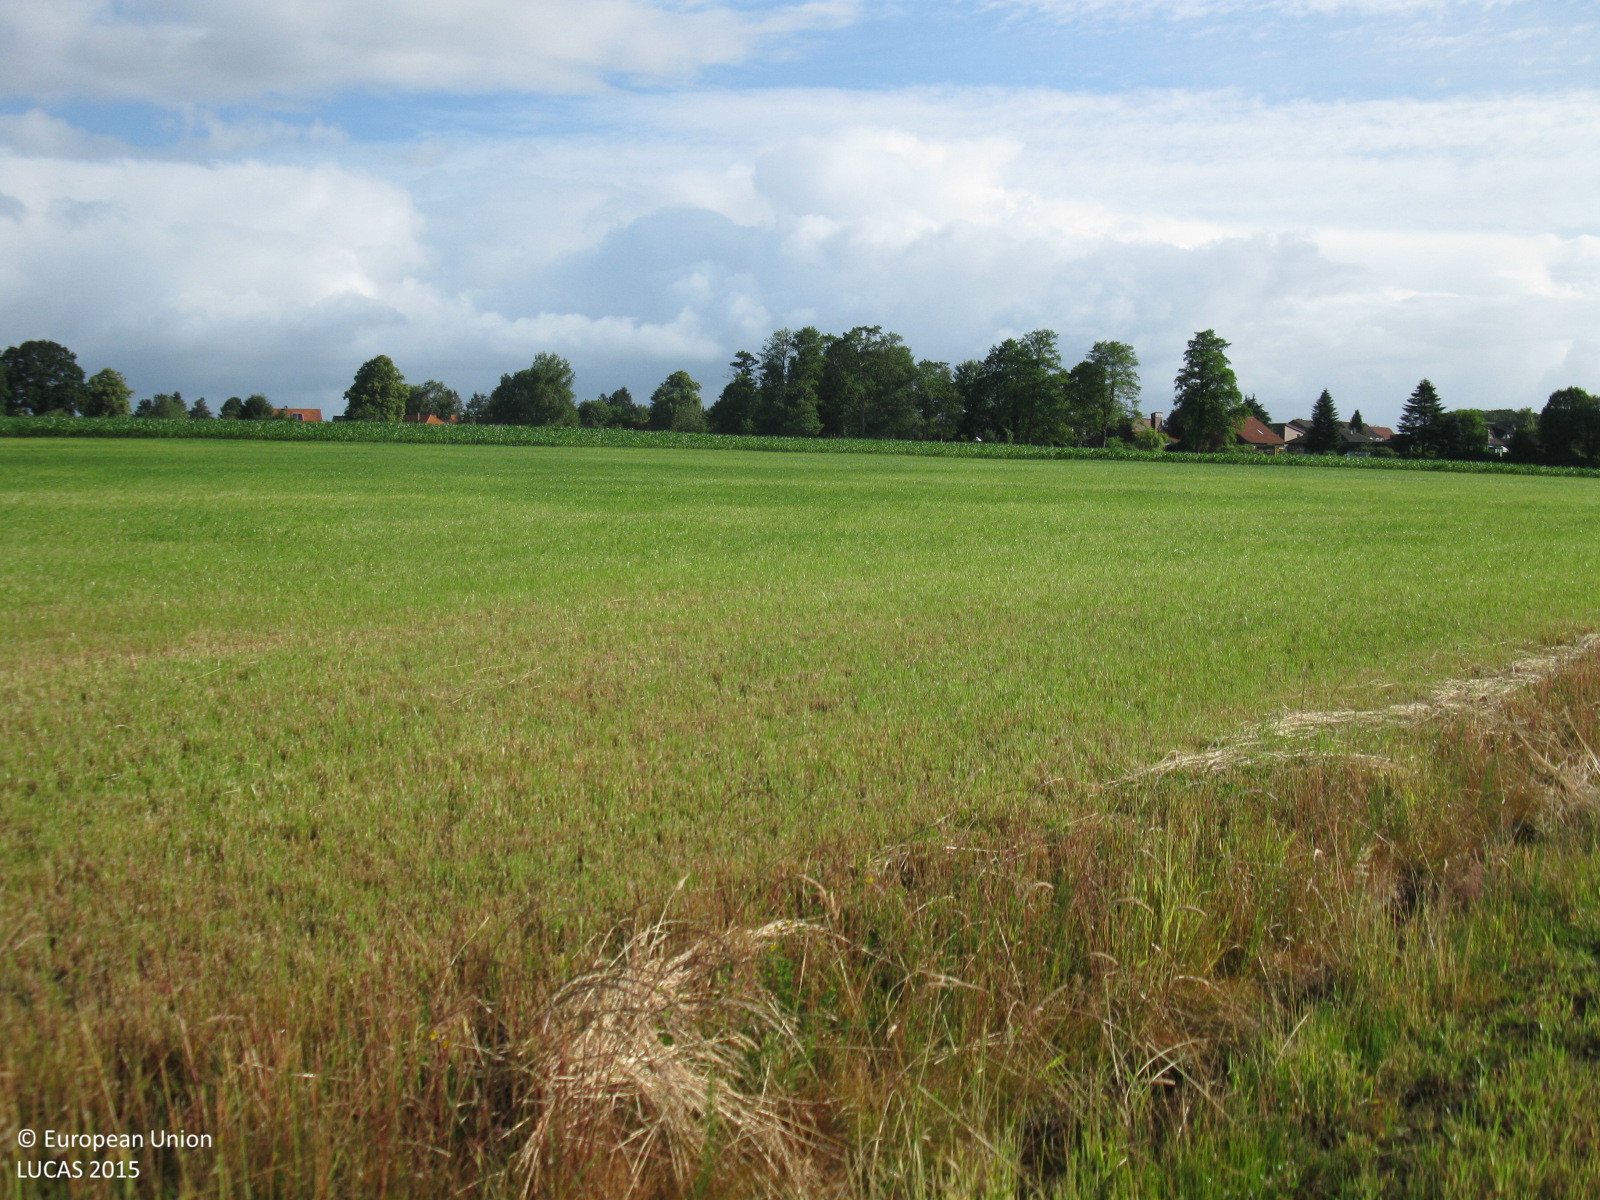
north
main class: Grassland
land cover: Grassland without tree/shrub cover
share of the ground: > 75 %
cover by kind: herbaceous plants 100 %
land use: Agriculture (excluding fallow land and kitchen gardens)
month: July
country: DE
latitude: 53.4029
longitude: 7.9701
